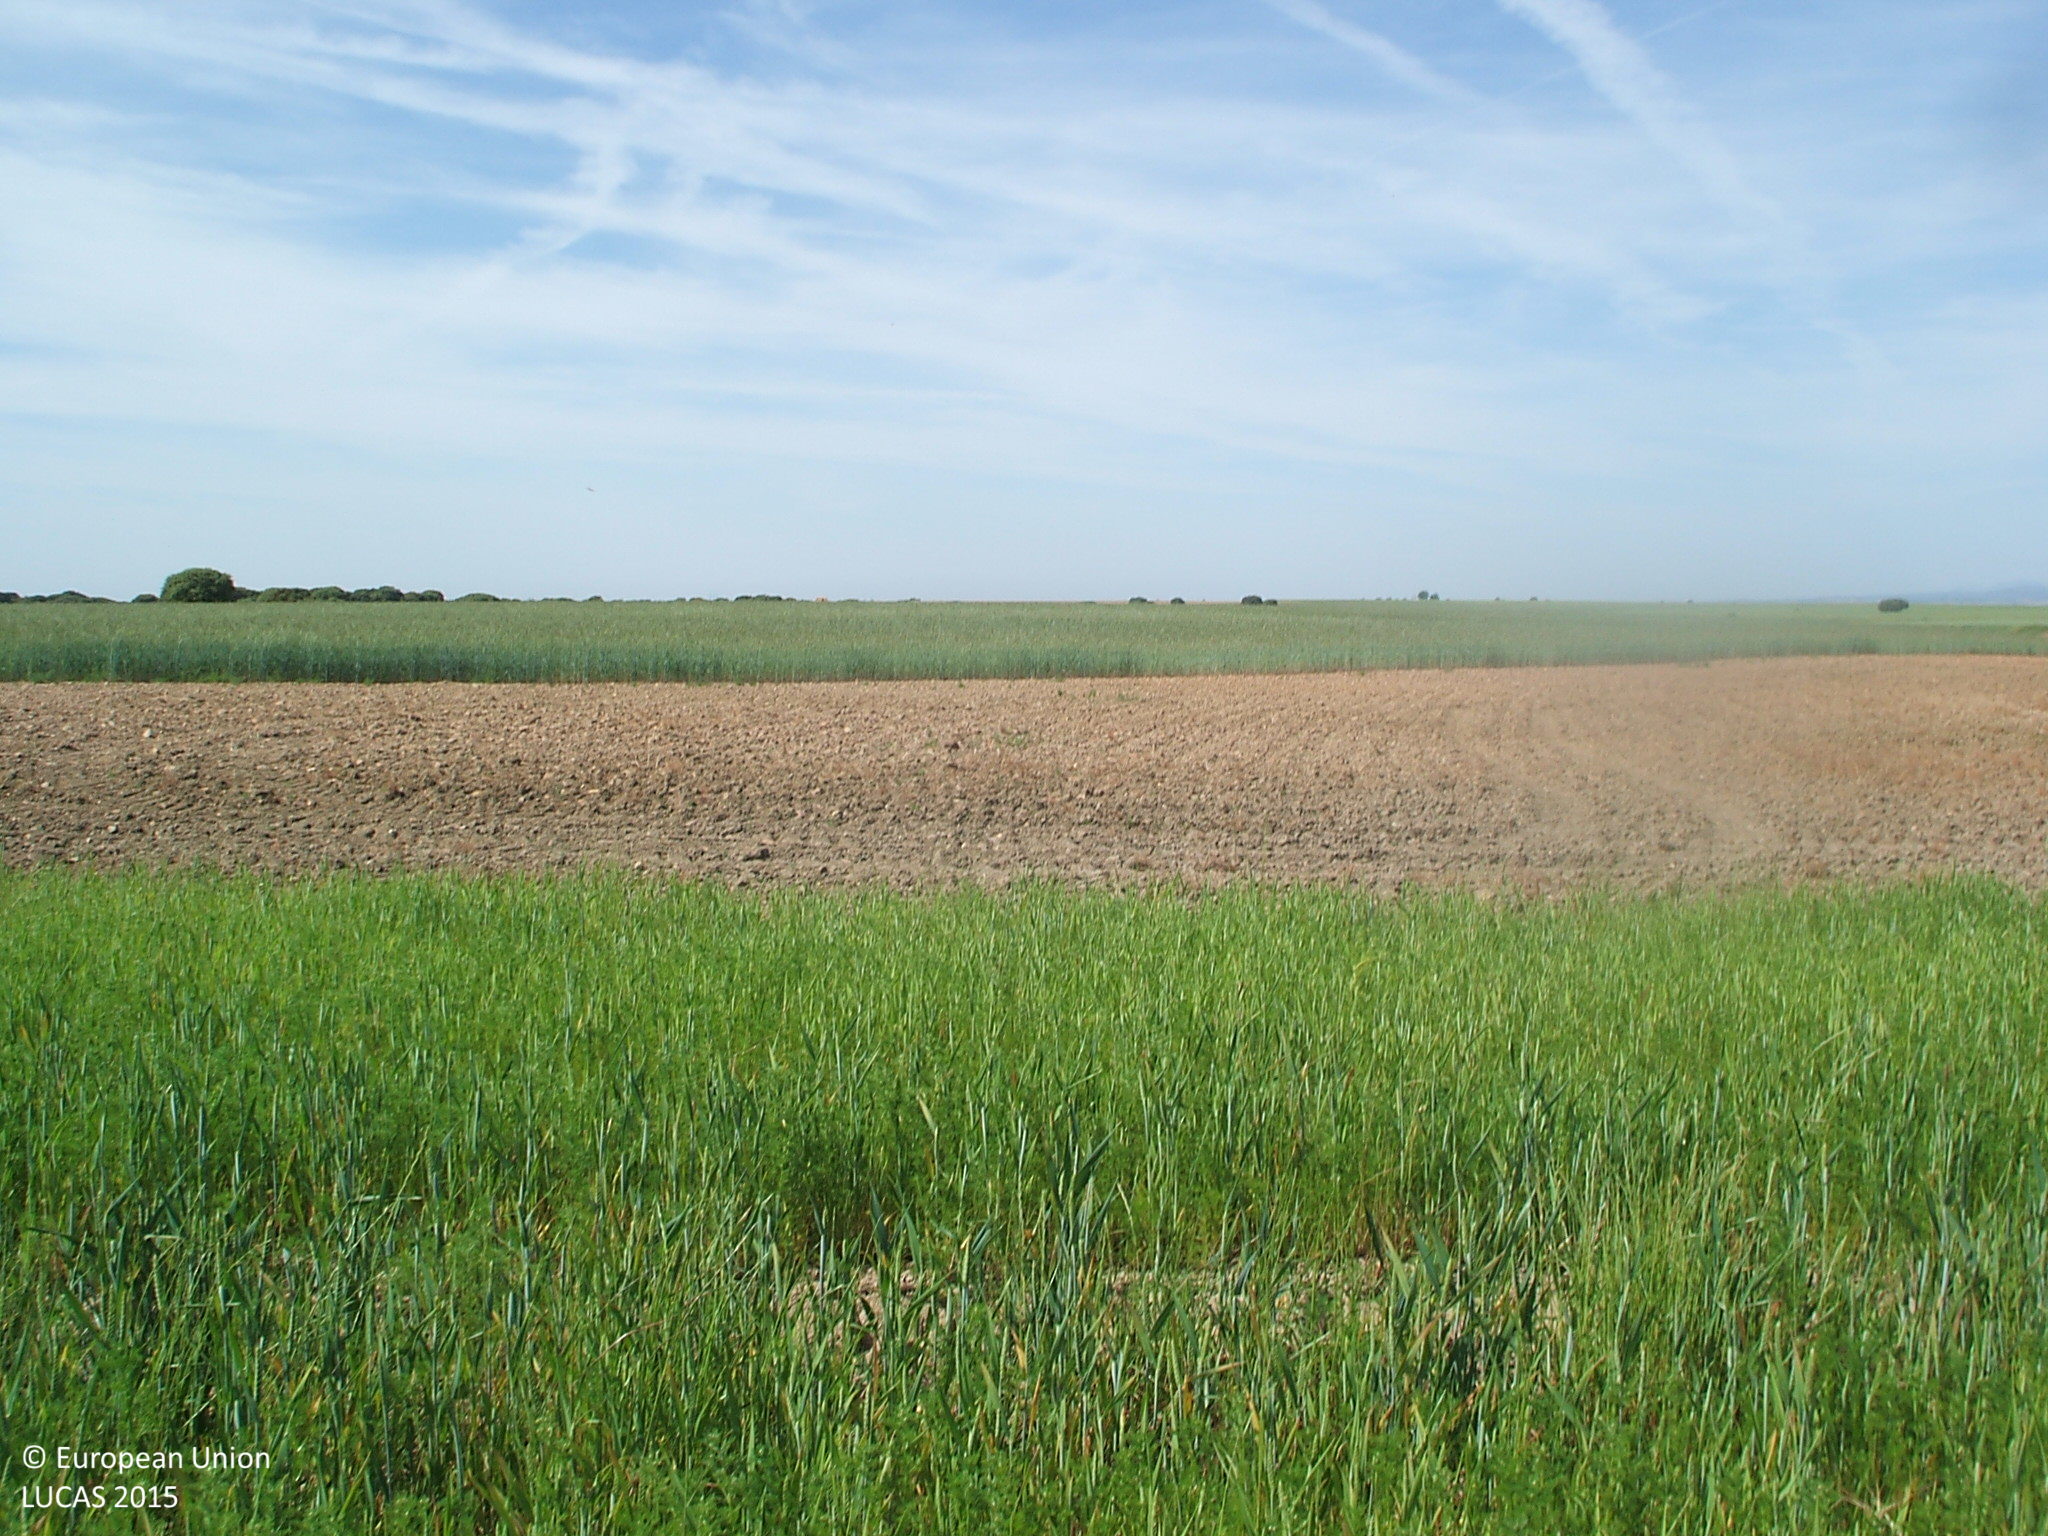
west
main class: Cropland
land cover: Common wheat
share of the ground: > 75 %
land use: Agriculture (excluding fallow land and kitchen gardens)
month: May
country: ES
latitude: 40.8083
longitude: -3.3982
